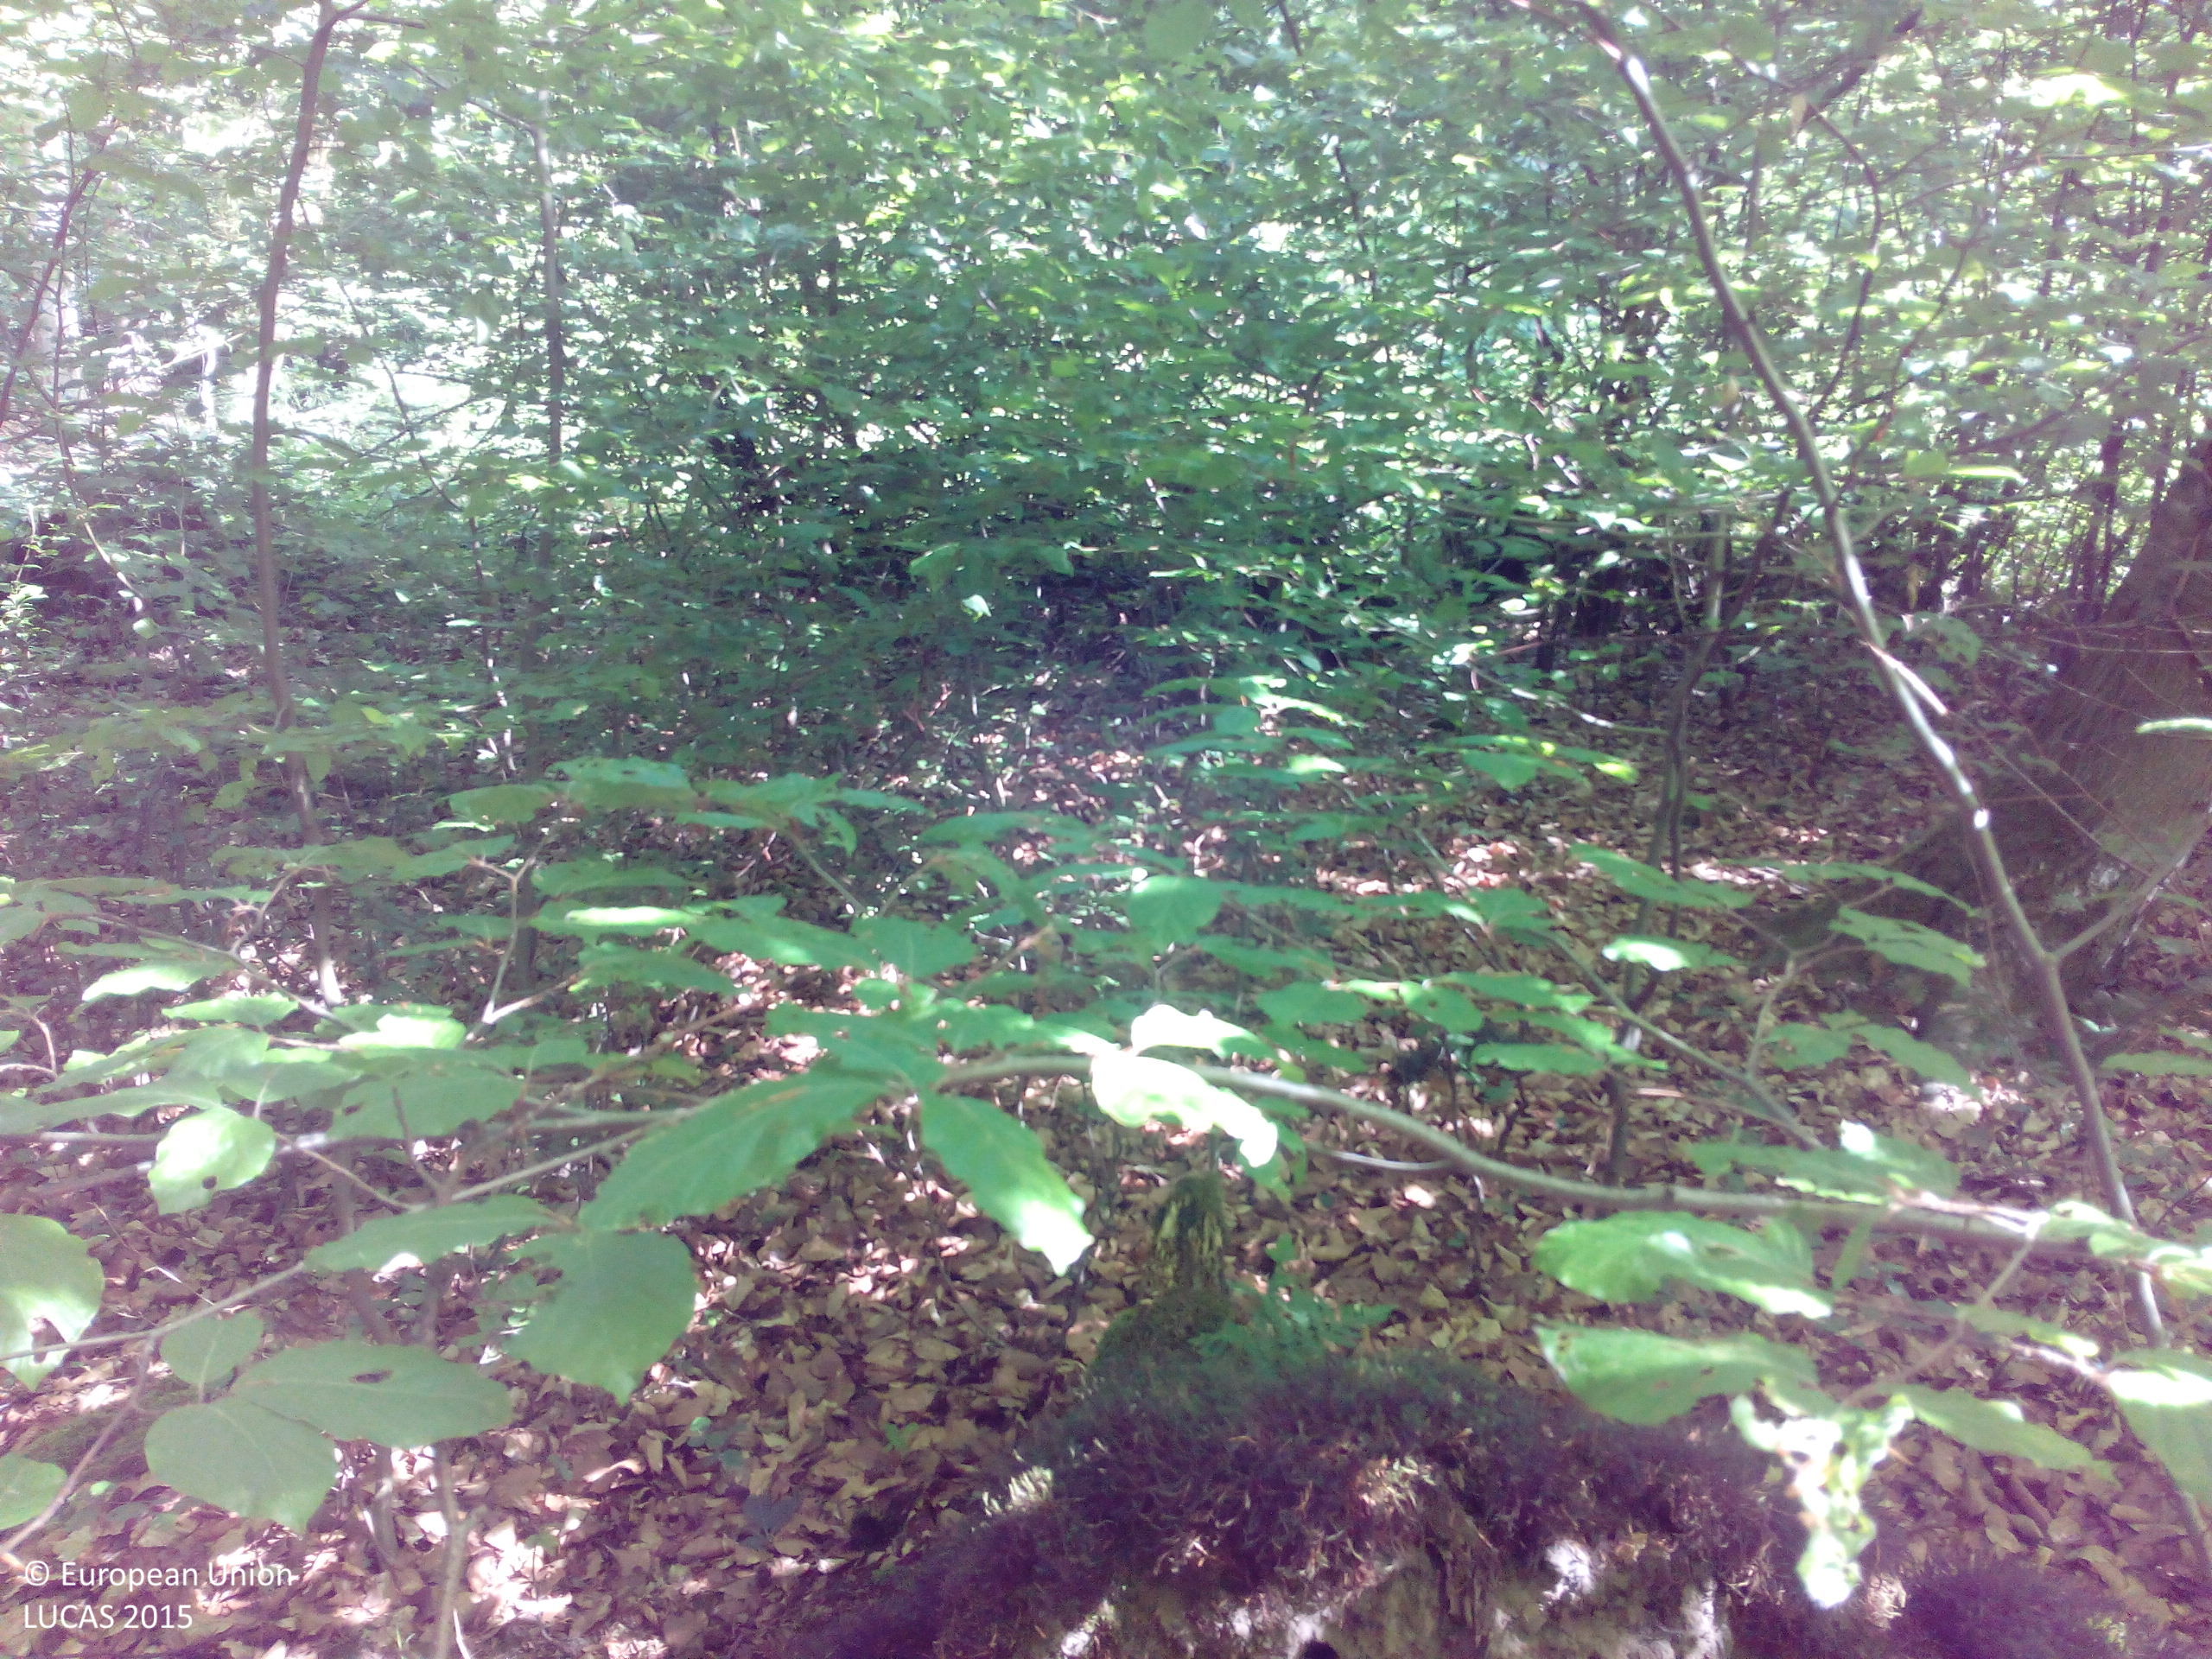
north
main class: Woodland
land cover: Broadleaved woodland
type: mesophytic deciduous forest
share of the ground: > 75 %
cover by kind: broadleaved forest trees 85 %, unconsolidated bare surface 15 %
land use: Forestry
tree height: > 5 m
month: May
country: DE
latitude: 49.9407
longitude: 8.5095
